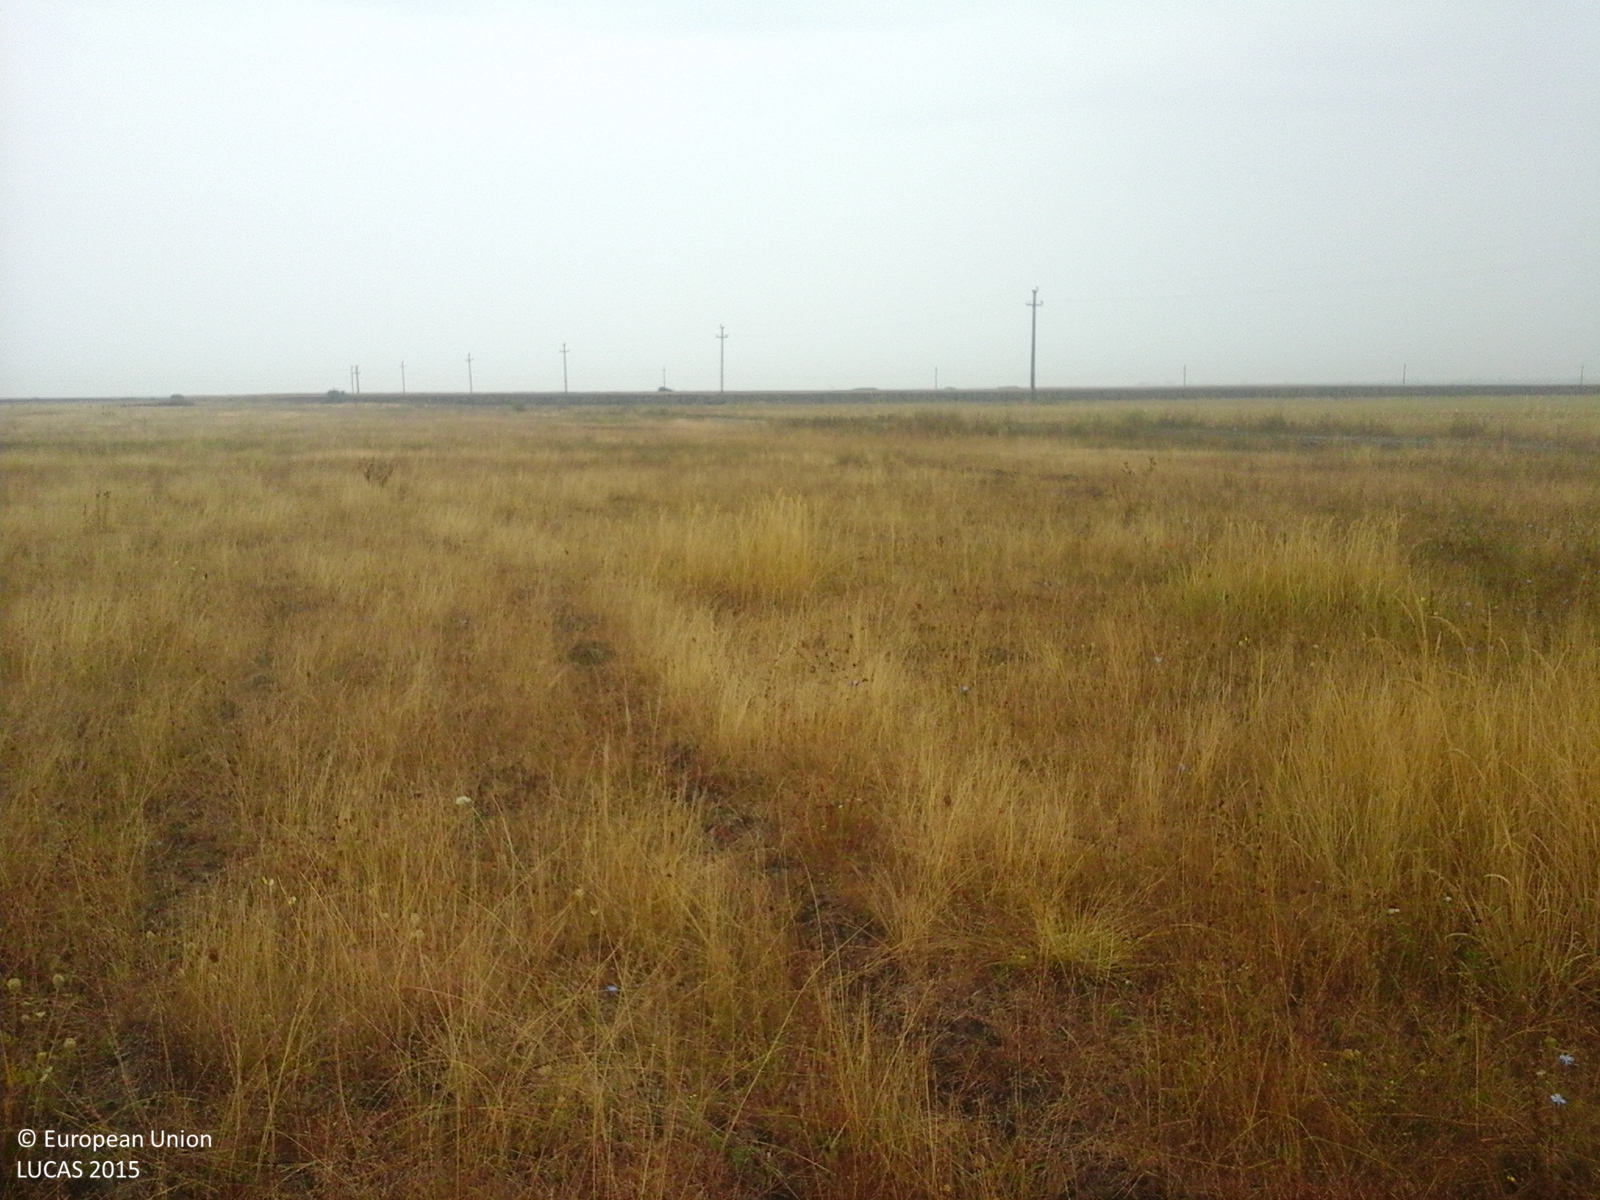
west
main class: Grassland
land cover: Grassland without tree/shrub cover
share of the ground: > 75 %
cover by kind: herbaceous plants 100 %
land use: Agriculture (excluding fallow land and kitchen gardens)
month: September
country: RO
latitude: 47.5945
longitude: 22.5460
